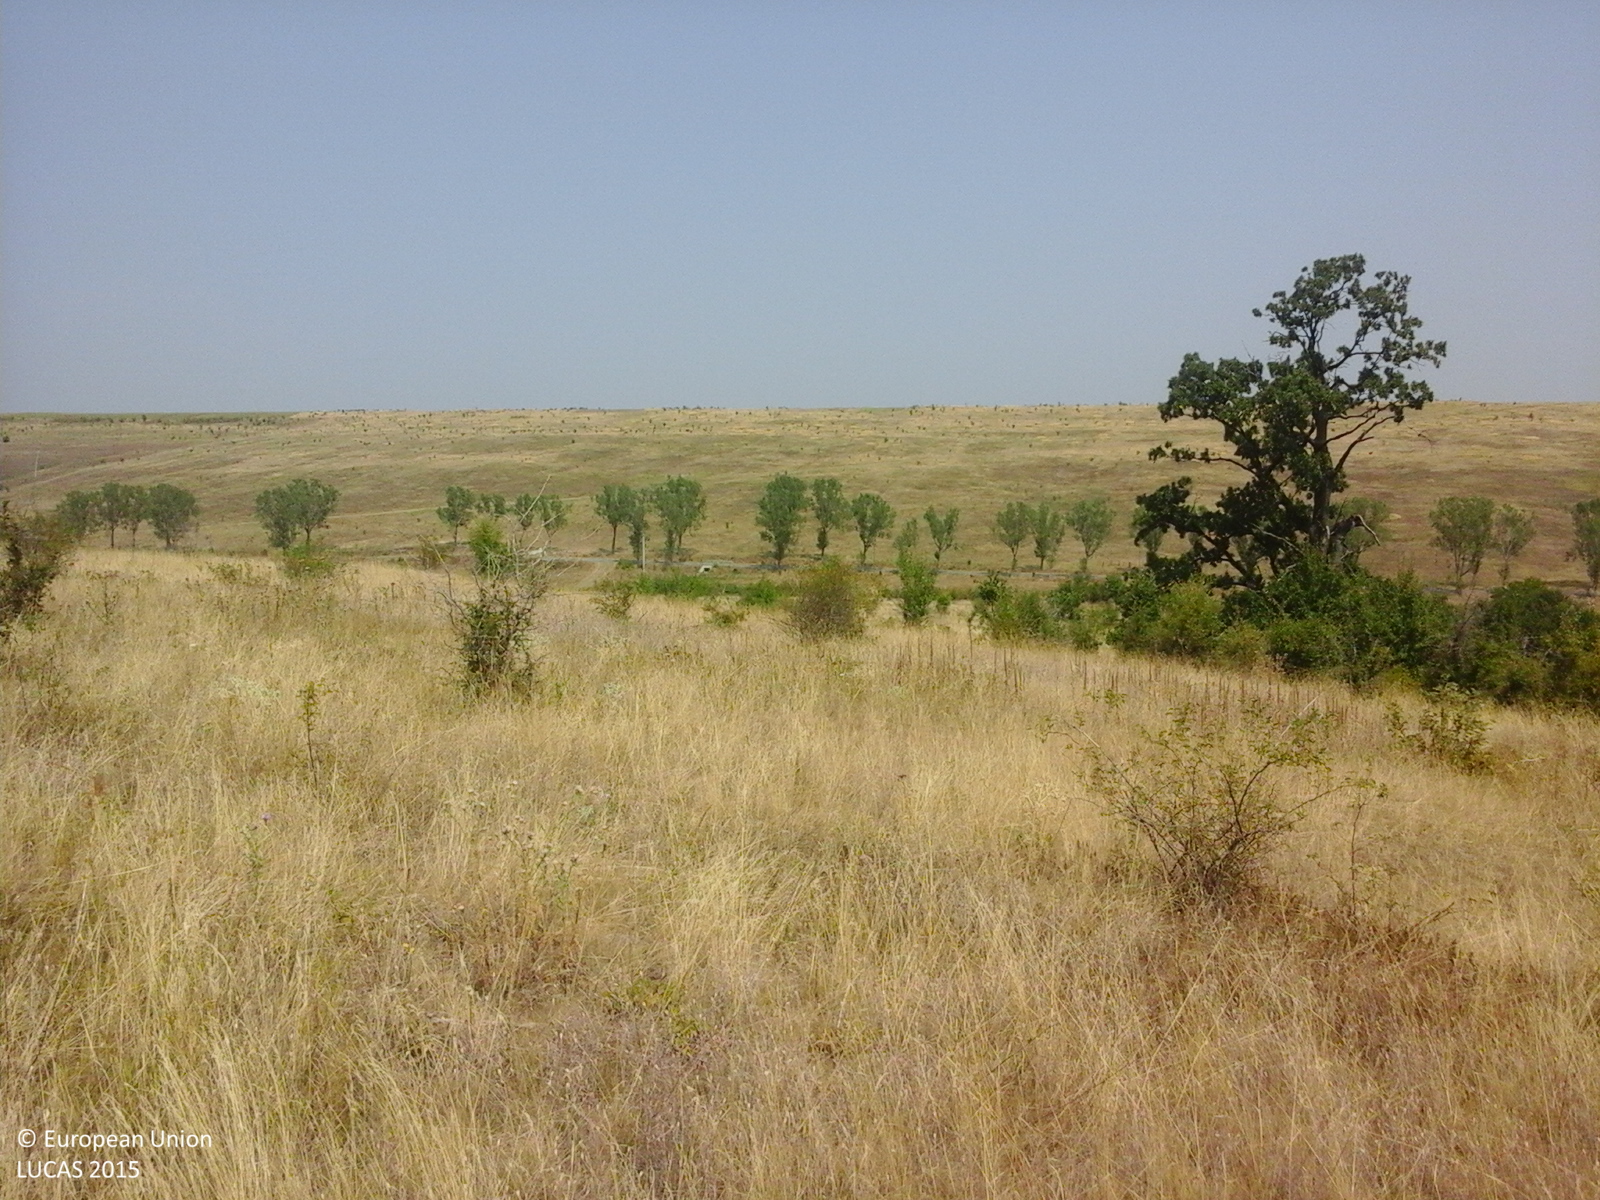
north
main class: Grassland
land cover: Grassland with sparse tree/shrub cover
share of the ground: > 75 %
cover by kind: herbaceous plants 95 %, broadleaved forest trees 5 %
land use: Agriculture (excluding fallow land and kitchen gardens)
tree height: > 5 m
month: August
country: RO
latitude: 44.3617
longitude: 23.3372
